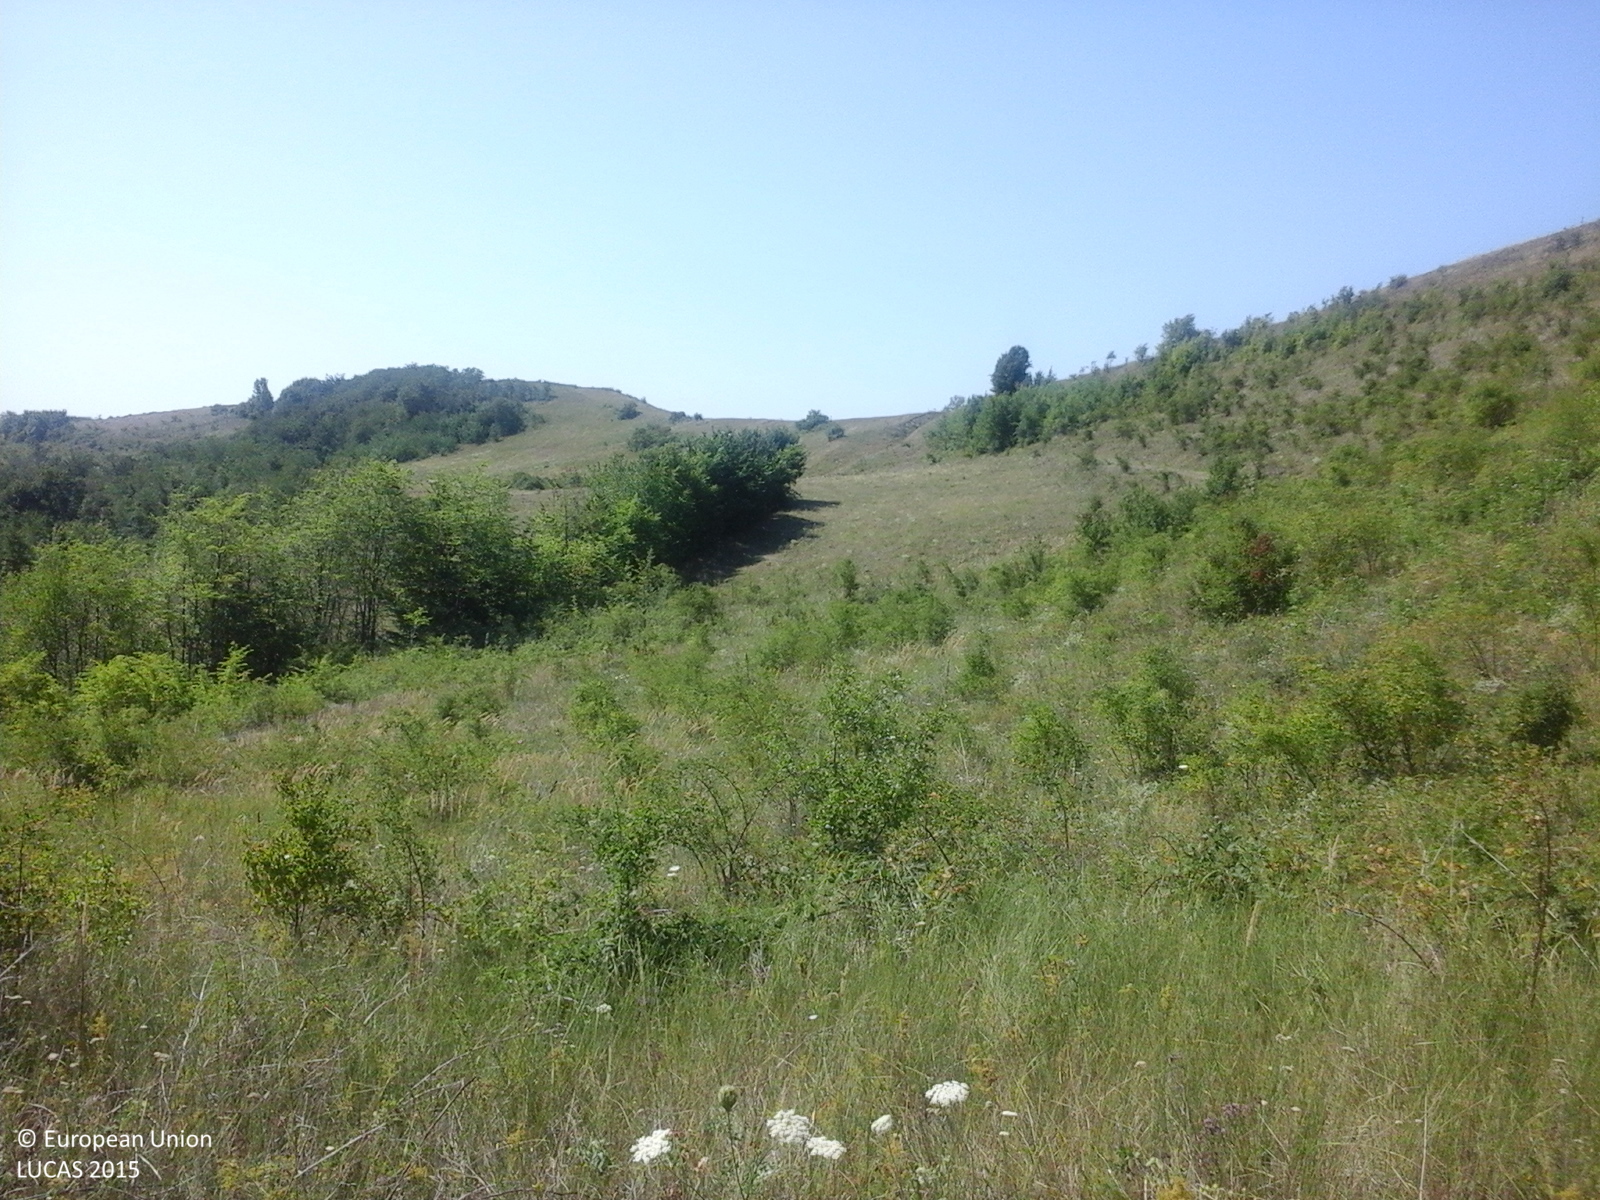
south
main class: Shrubland
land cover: Shrubland with sparse tree cover
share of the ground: > 75 %
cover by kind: shrubs 75 %, herbaceous plants 20 %, broadleaved forest trees 5 %
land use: Semi-natural and natural areas not in use
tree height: > 5 m
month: July
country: RO
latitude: 46.5412
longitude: 27.2244
